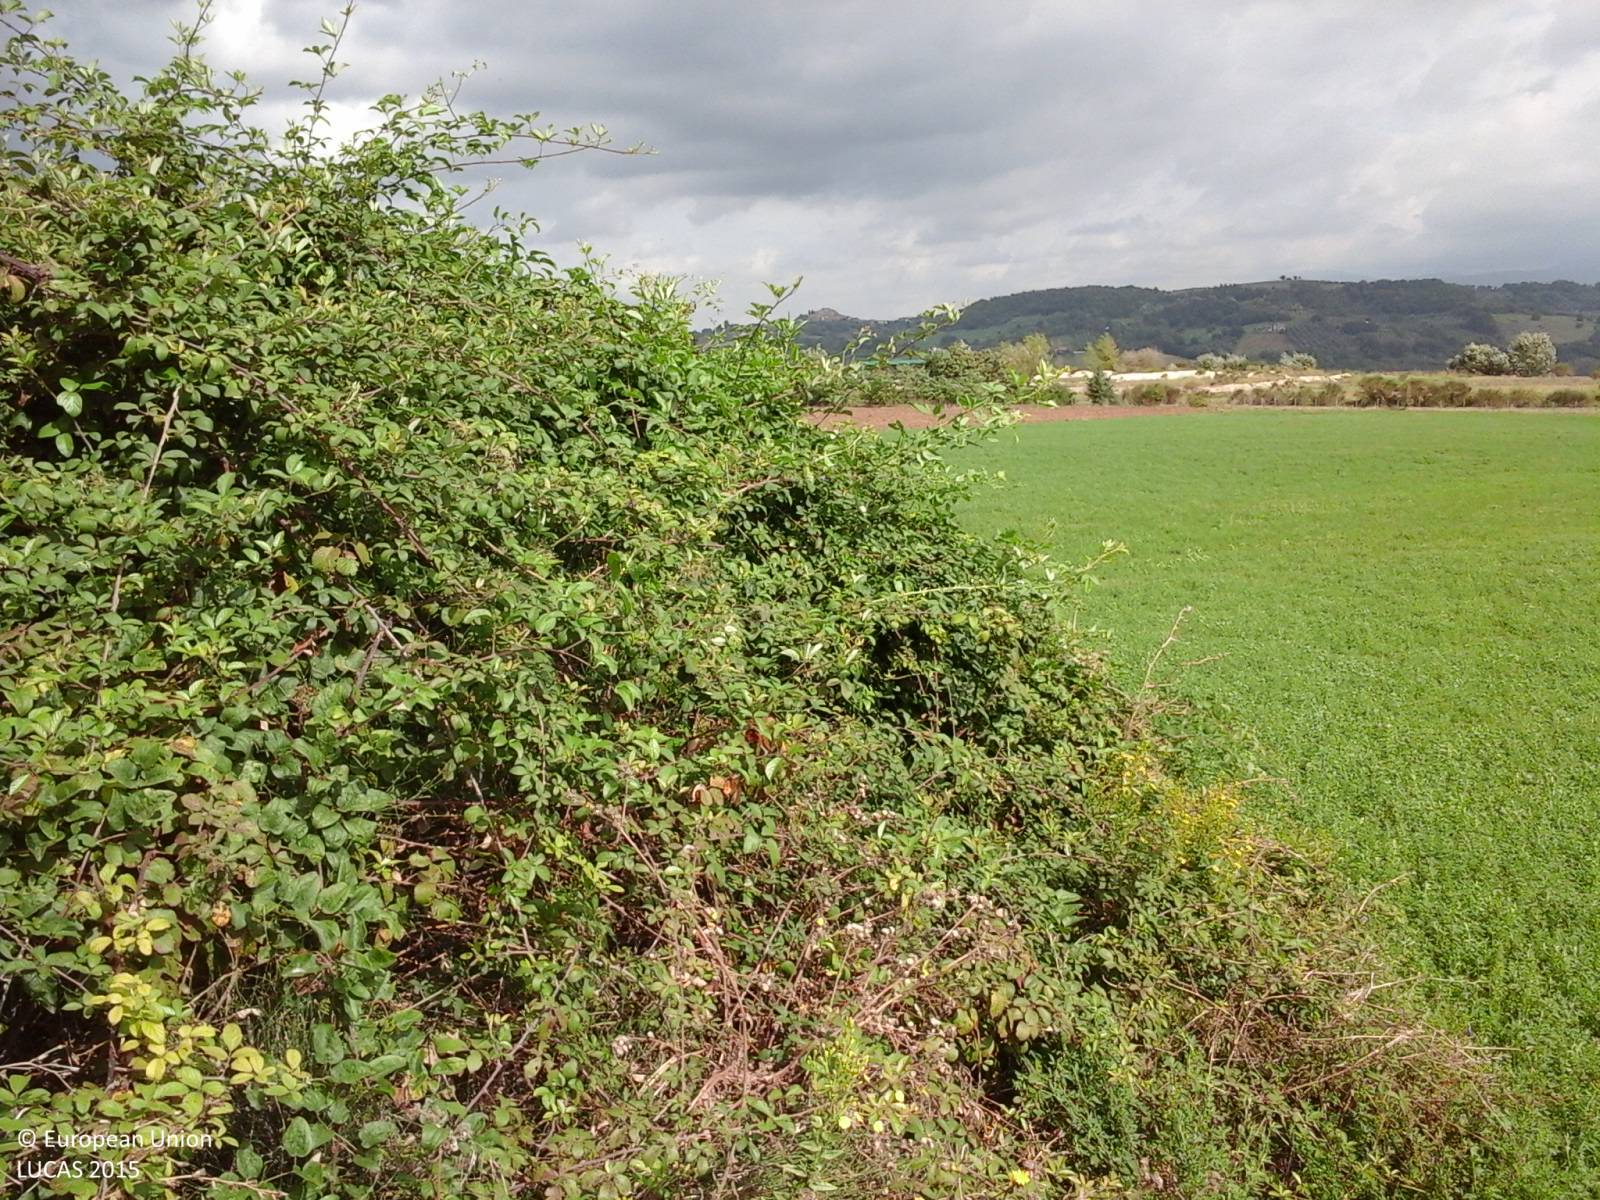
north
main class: Cropland
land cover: Lucerne
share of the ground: > 75 %
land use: Agriculture (excluding fallow land and kitchen gardens)
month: September
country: IT
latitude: 42.2792
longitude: 12.5256
